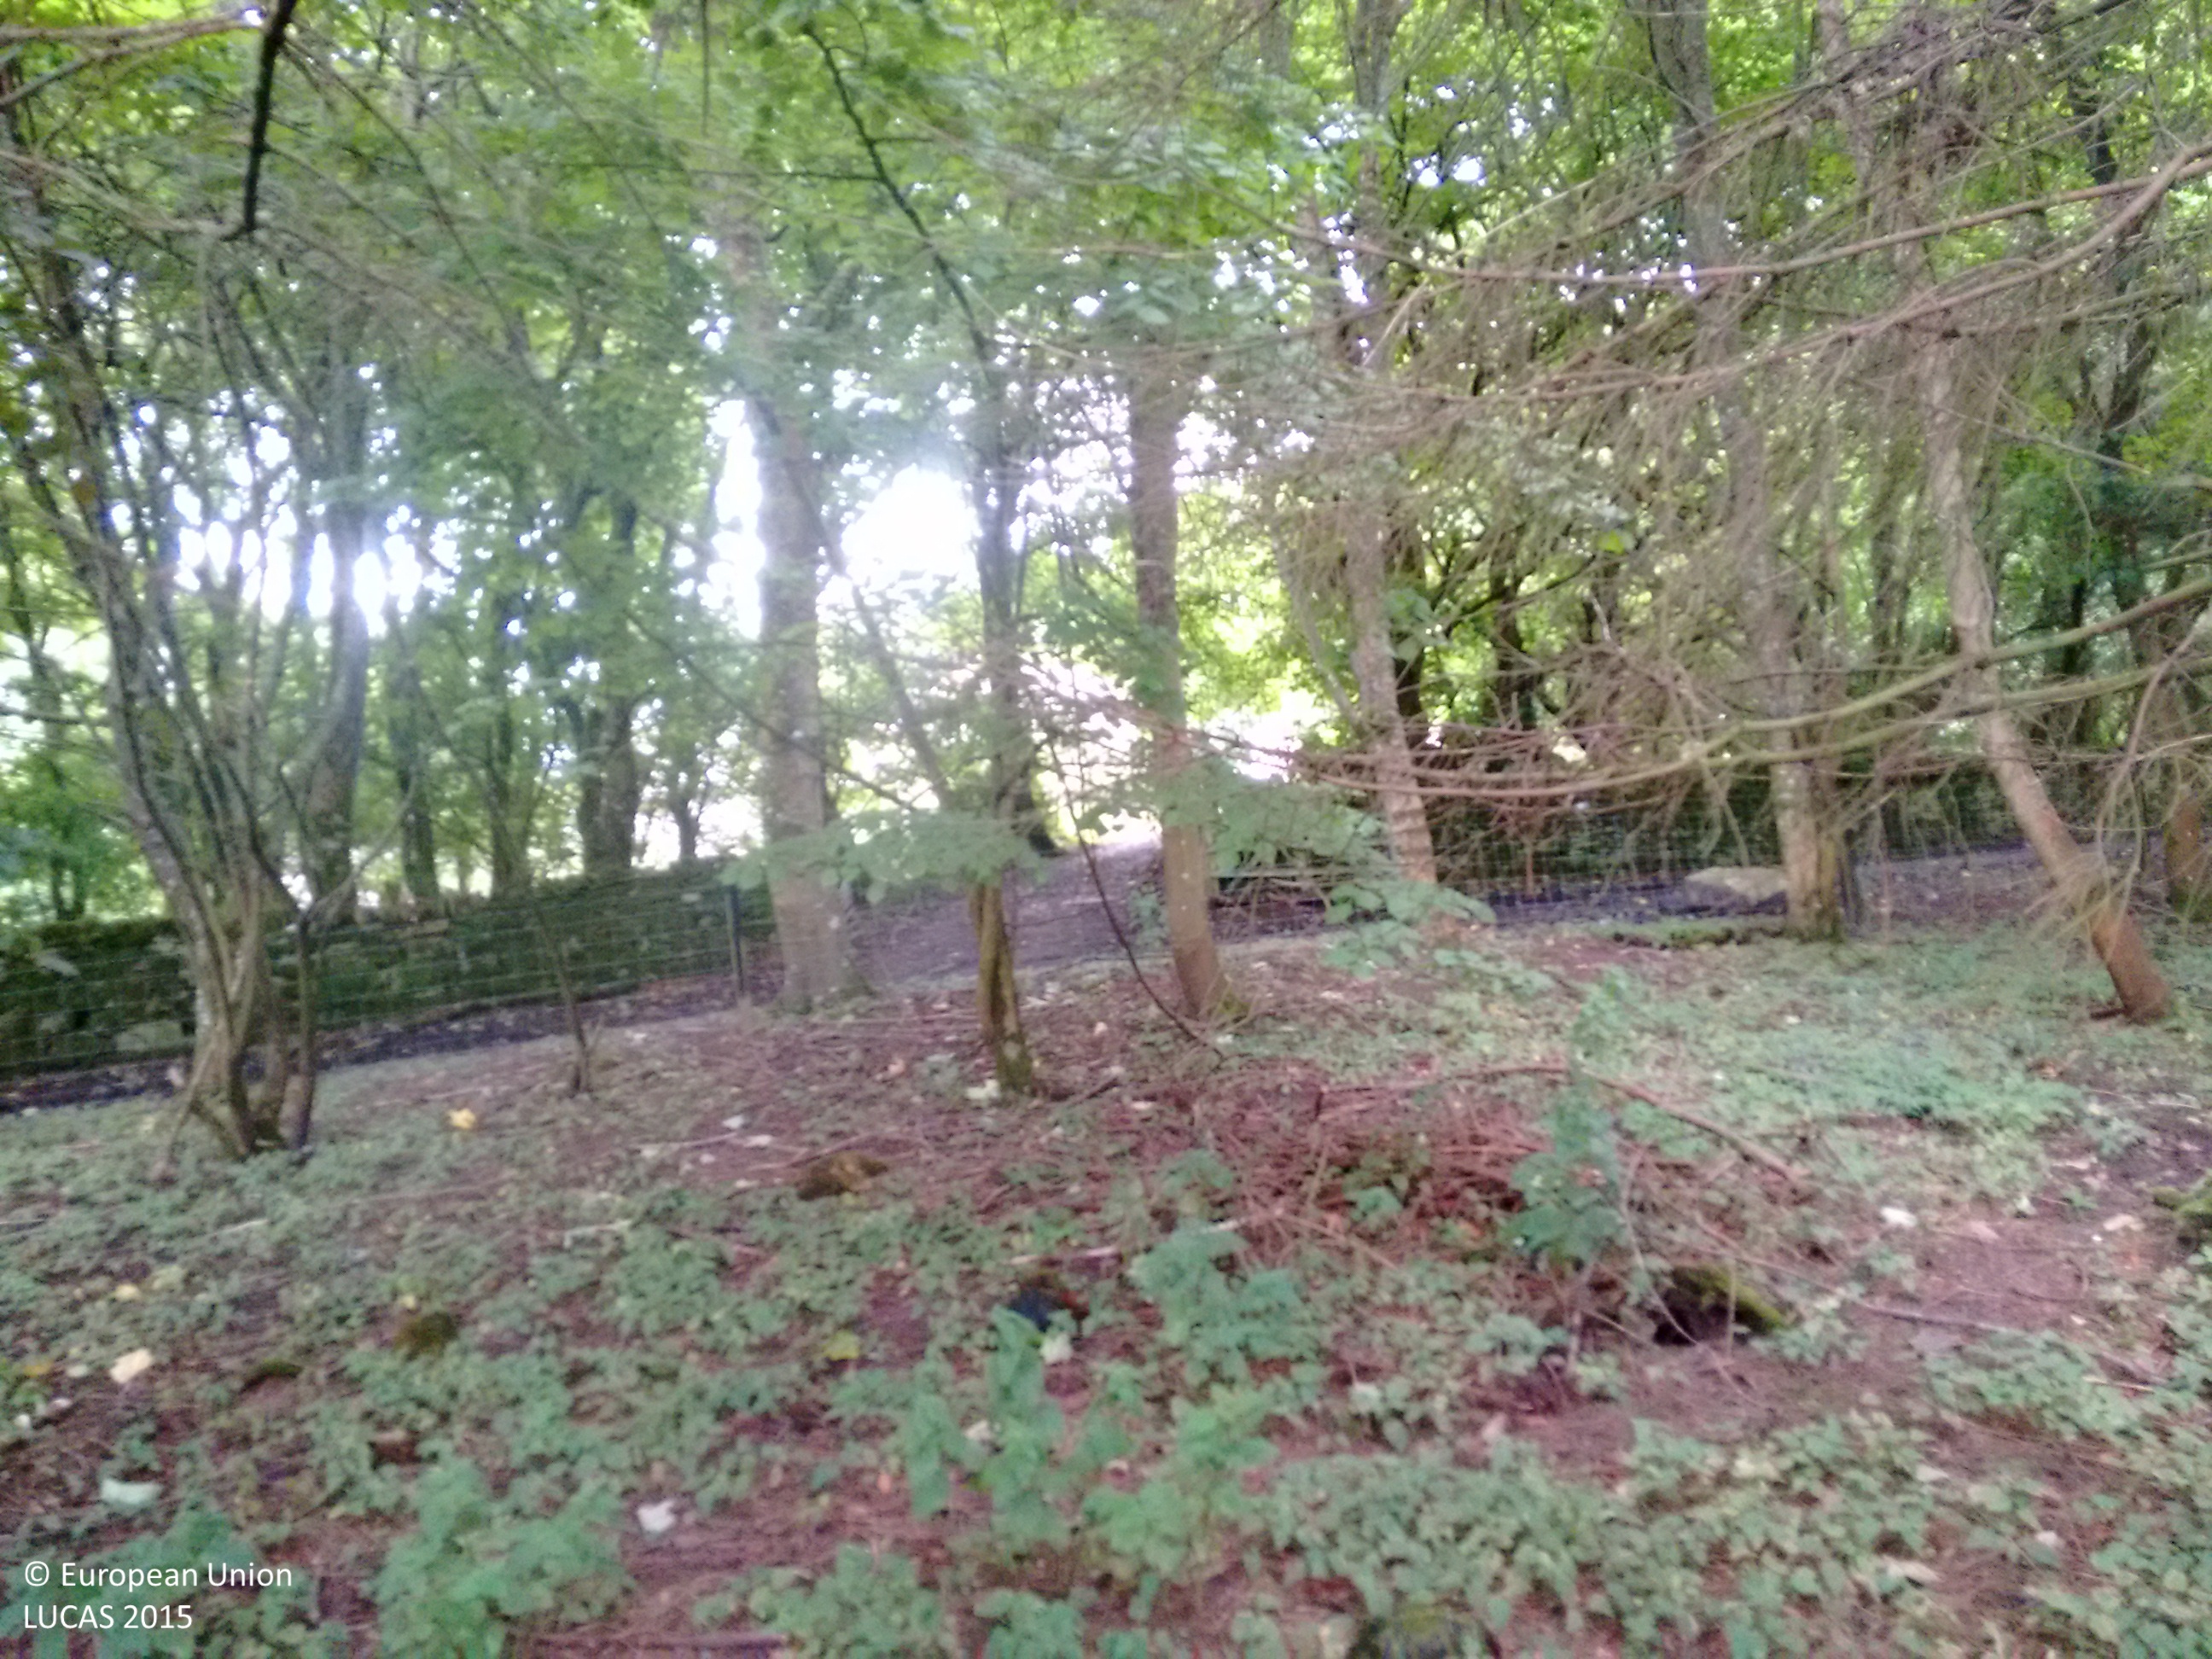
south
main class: Woodland
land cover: Other mixed woodland
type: exotic forest
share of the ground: > 75 %
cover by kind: coniferous forest trees 75 %, broadleaved forest trees 25 %
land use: Agriculture (excluding fallow land and kitchen gardens)
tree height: > 5 m
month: August
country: GB
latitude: 58.3921
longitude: -3.1455
